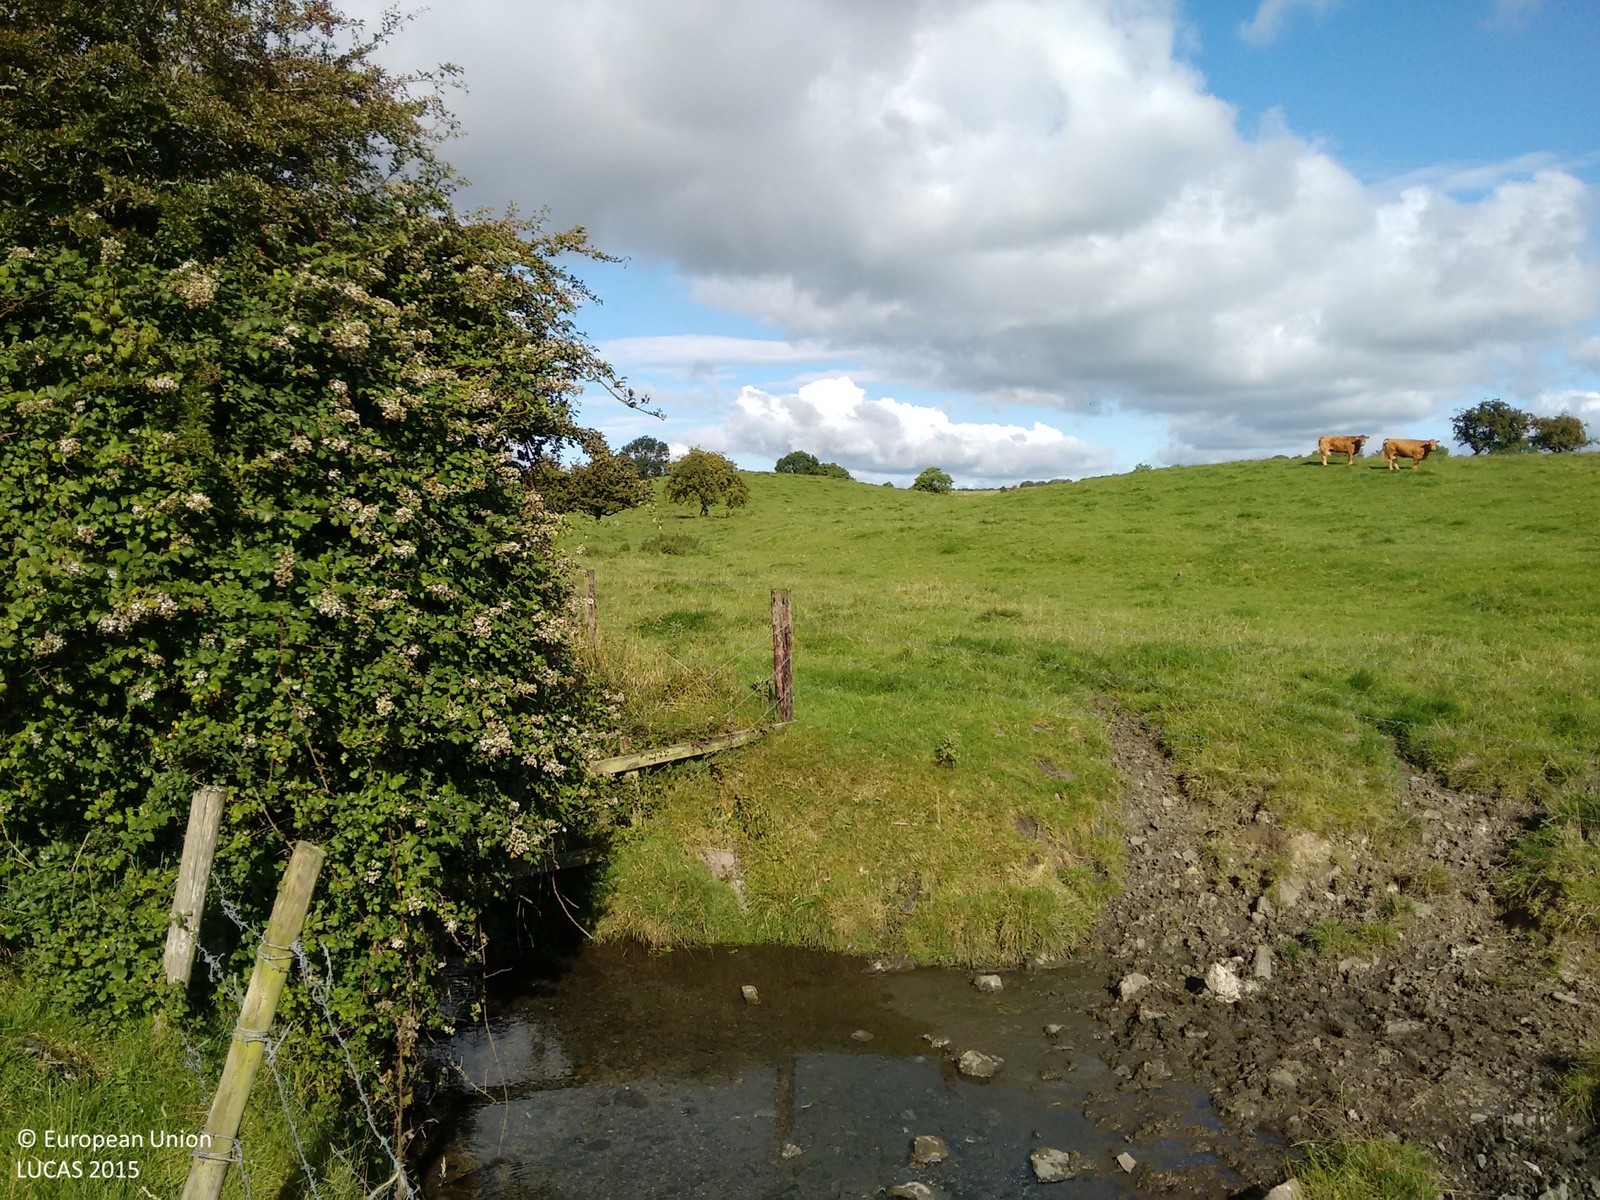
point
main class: Grassland
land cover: Grassland without tree/shrub cover
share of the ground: > 75 %
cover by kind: herbaceous plants 100 %
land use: Agriculture (excluding fallow land and kitchen gardens)
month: September
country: IE
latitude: 53.7010
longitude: -7.0942
